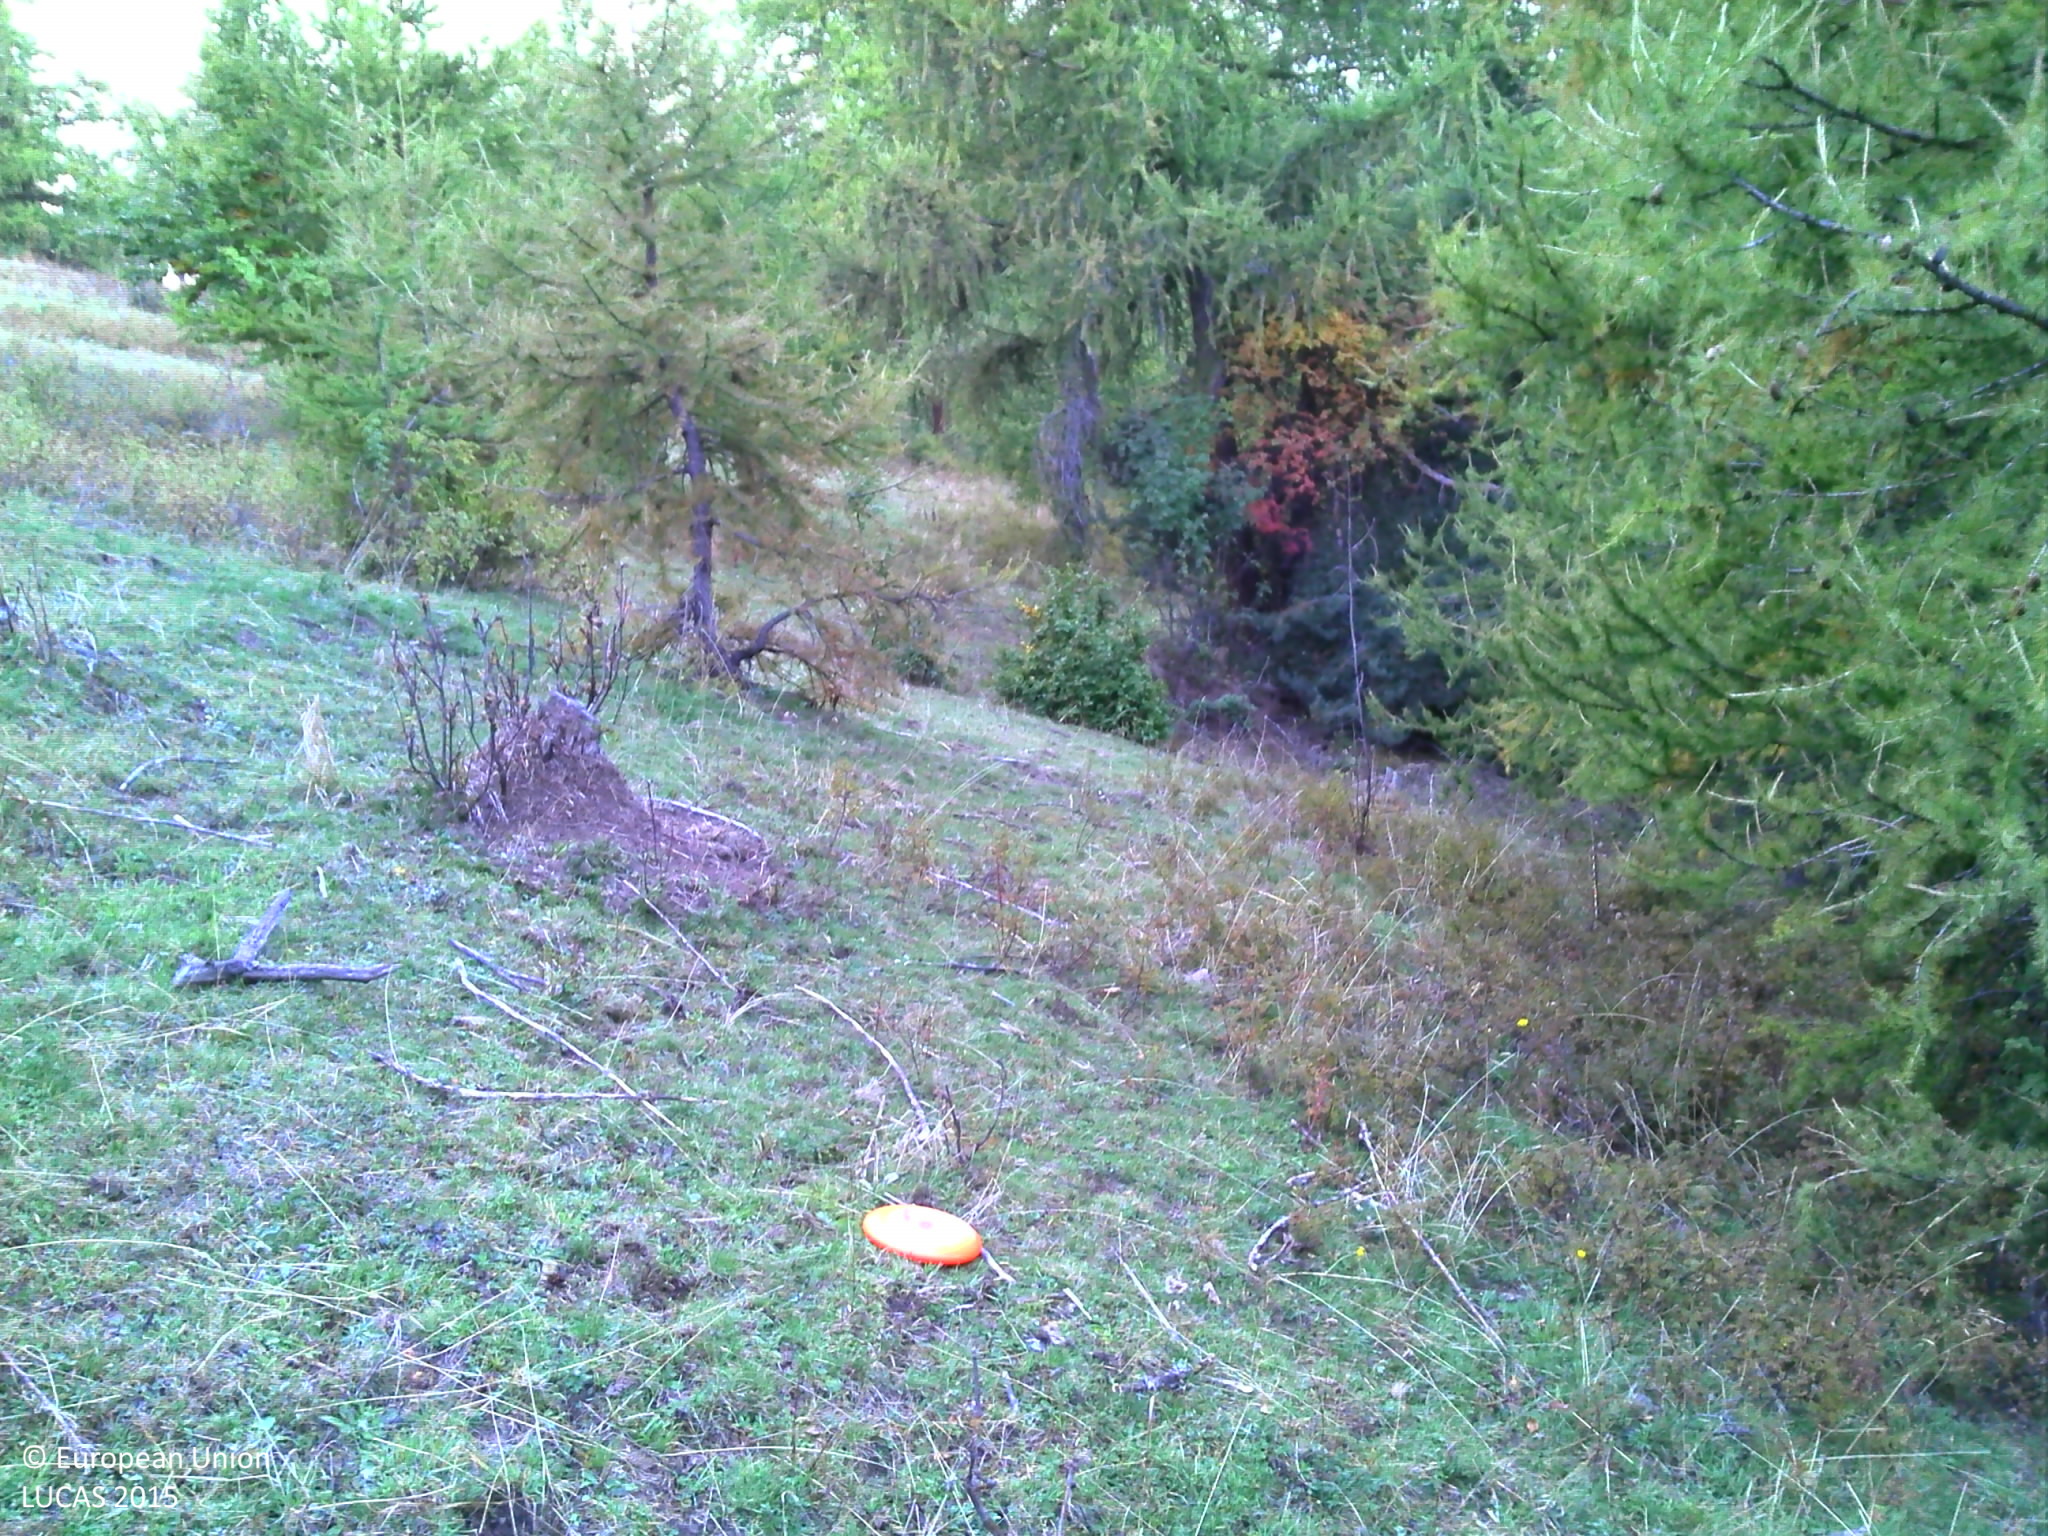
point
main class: Grassland
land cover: Grassland with sparse tree/shrub cover
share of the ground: > 75 %
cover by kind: herbaceous plants 85 %, shrubs 10 %, coniferous forest trees 5 %
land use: Agriculture (excluding fallow land and kitchen gardens)
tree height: > 5 m
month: September
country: FR
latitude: 44.4984
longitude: 6.2211
